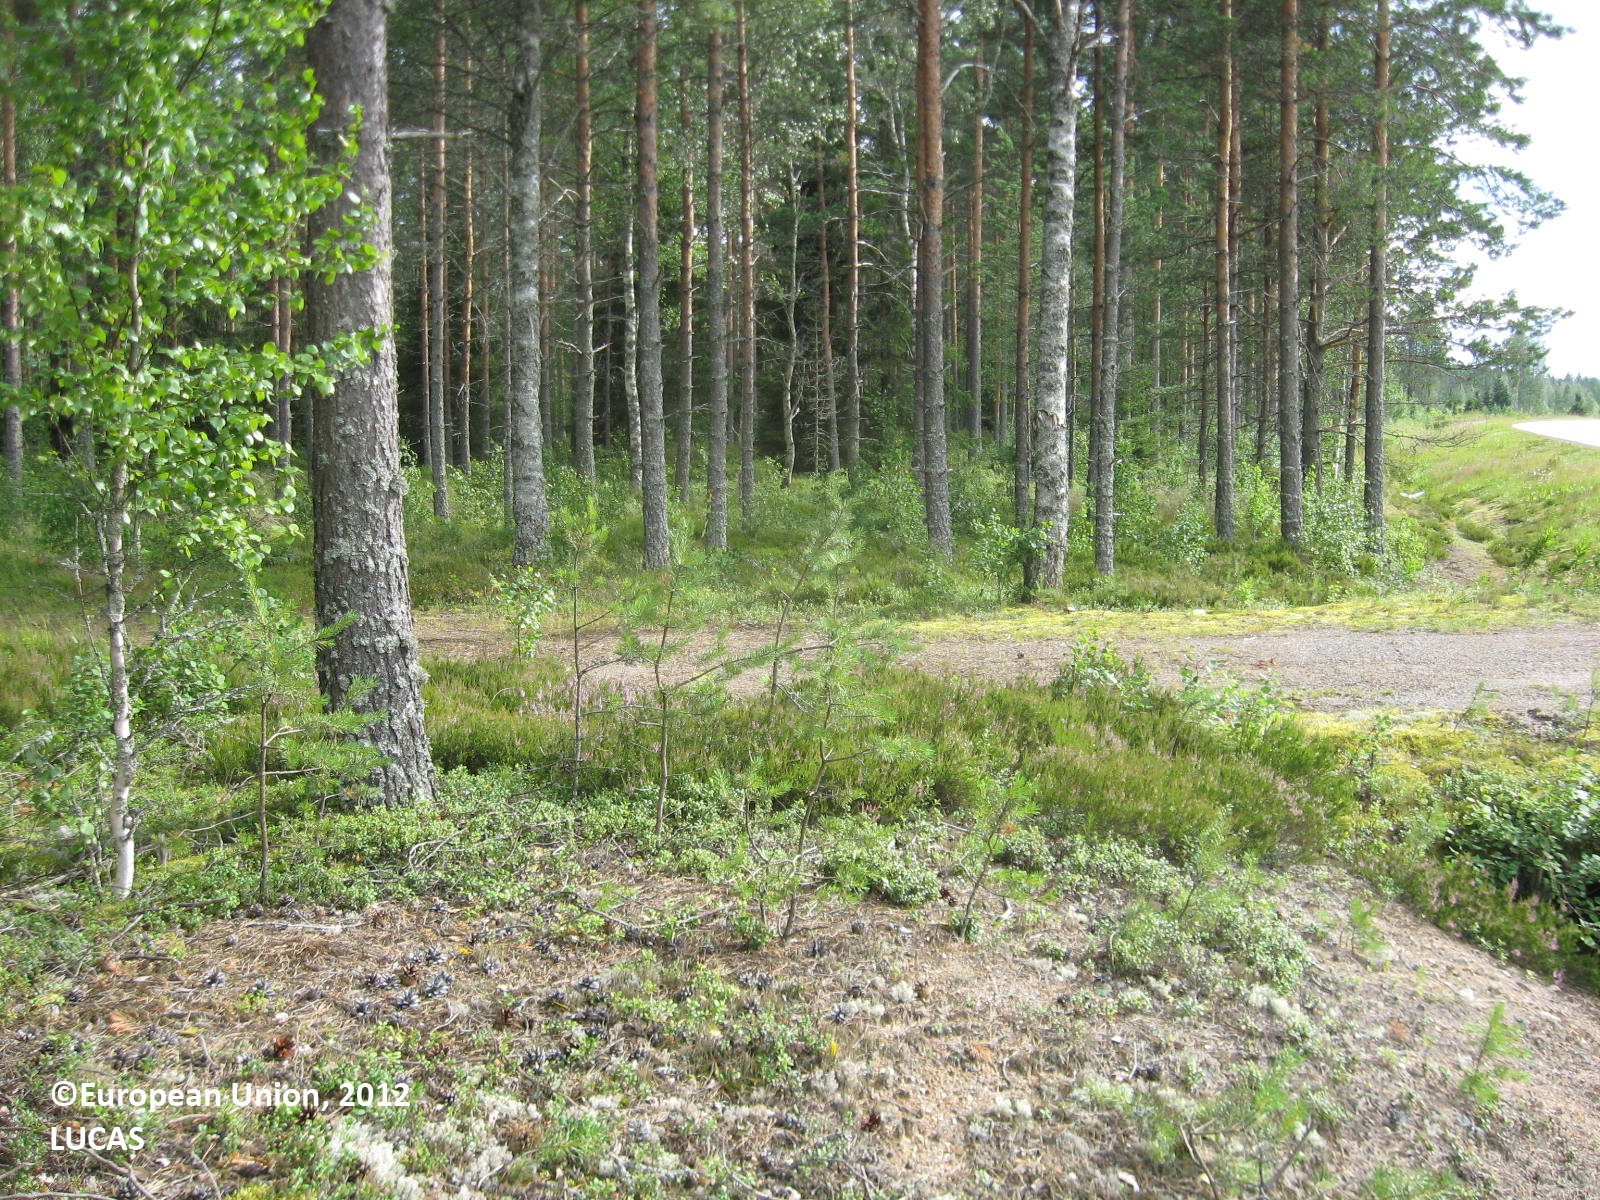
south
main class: Woodland
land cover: Pine dominated coniferous woodland
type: boreal forest
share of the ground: > 75 %
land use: Forestry
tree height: > 5 m
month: July
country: FI
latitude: 62.1798
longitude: 22.2903
